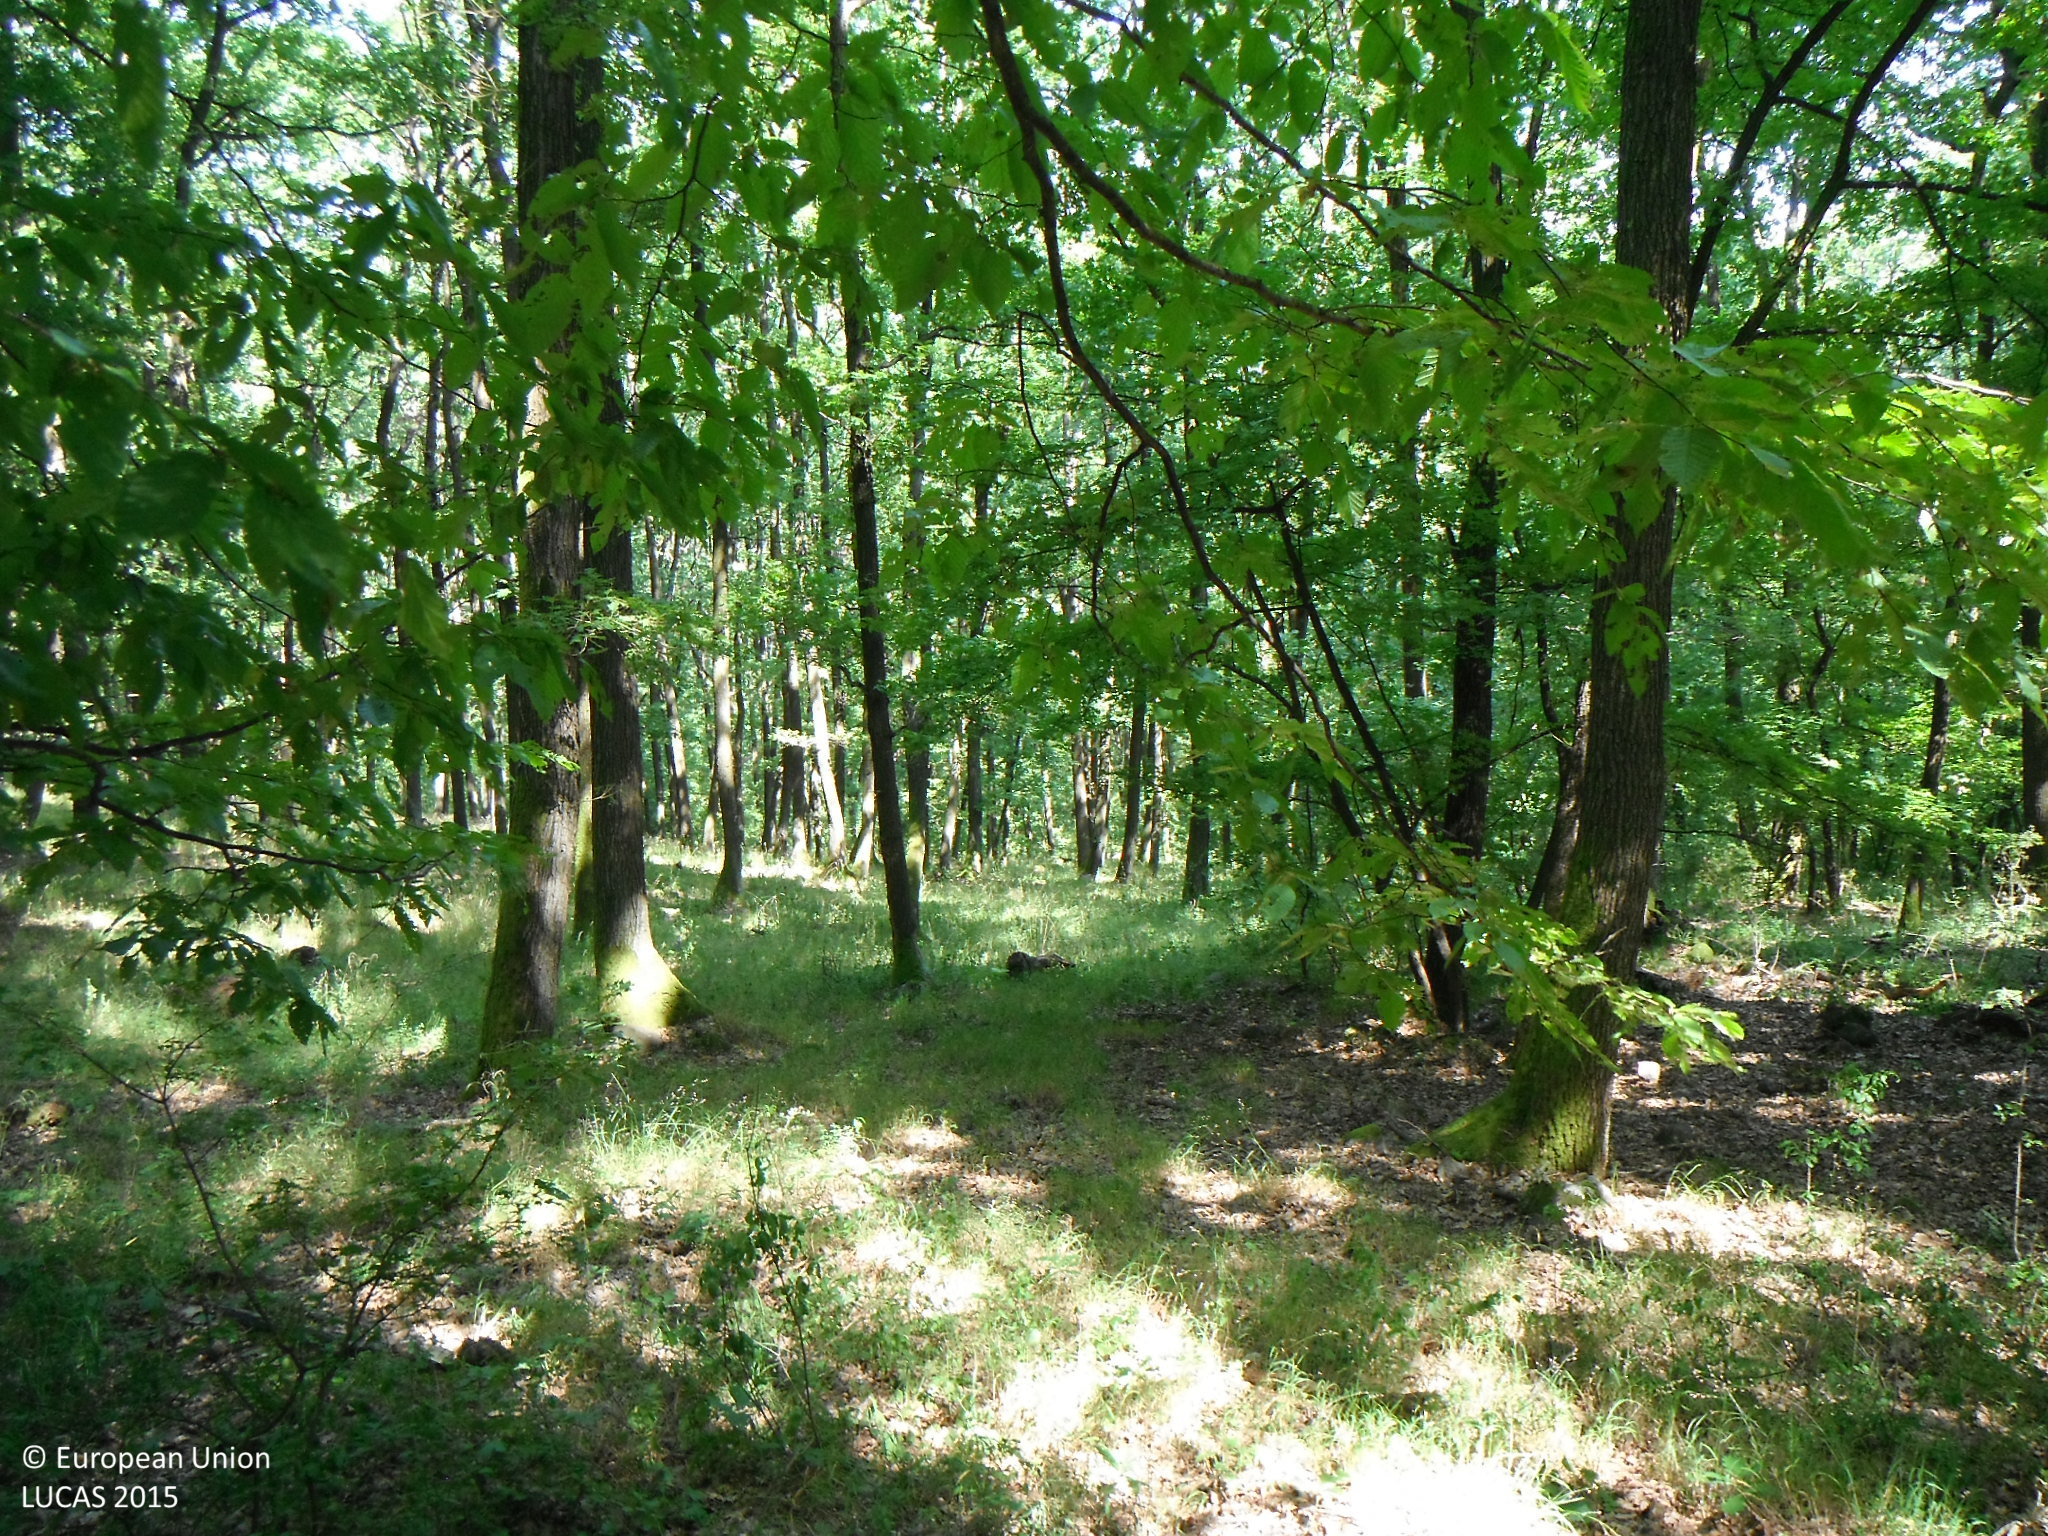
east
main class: Woodland
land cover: Broadleaved woodland
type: acidophilous oak and oak-birch forest
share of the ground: > 75 %
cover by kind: broadleaved forest trees 100 %
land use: Forestry
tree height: > 5 m
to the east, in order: Broadleaved woodland; Tracks; Broadleaved woodland
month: July
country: SK
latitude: 48.1370
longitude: 19.0910
